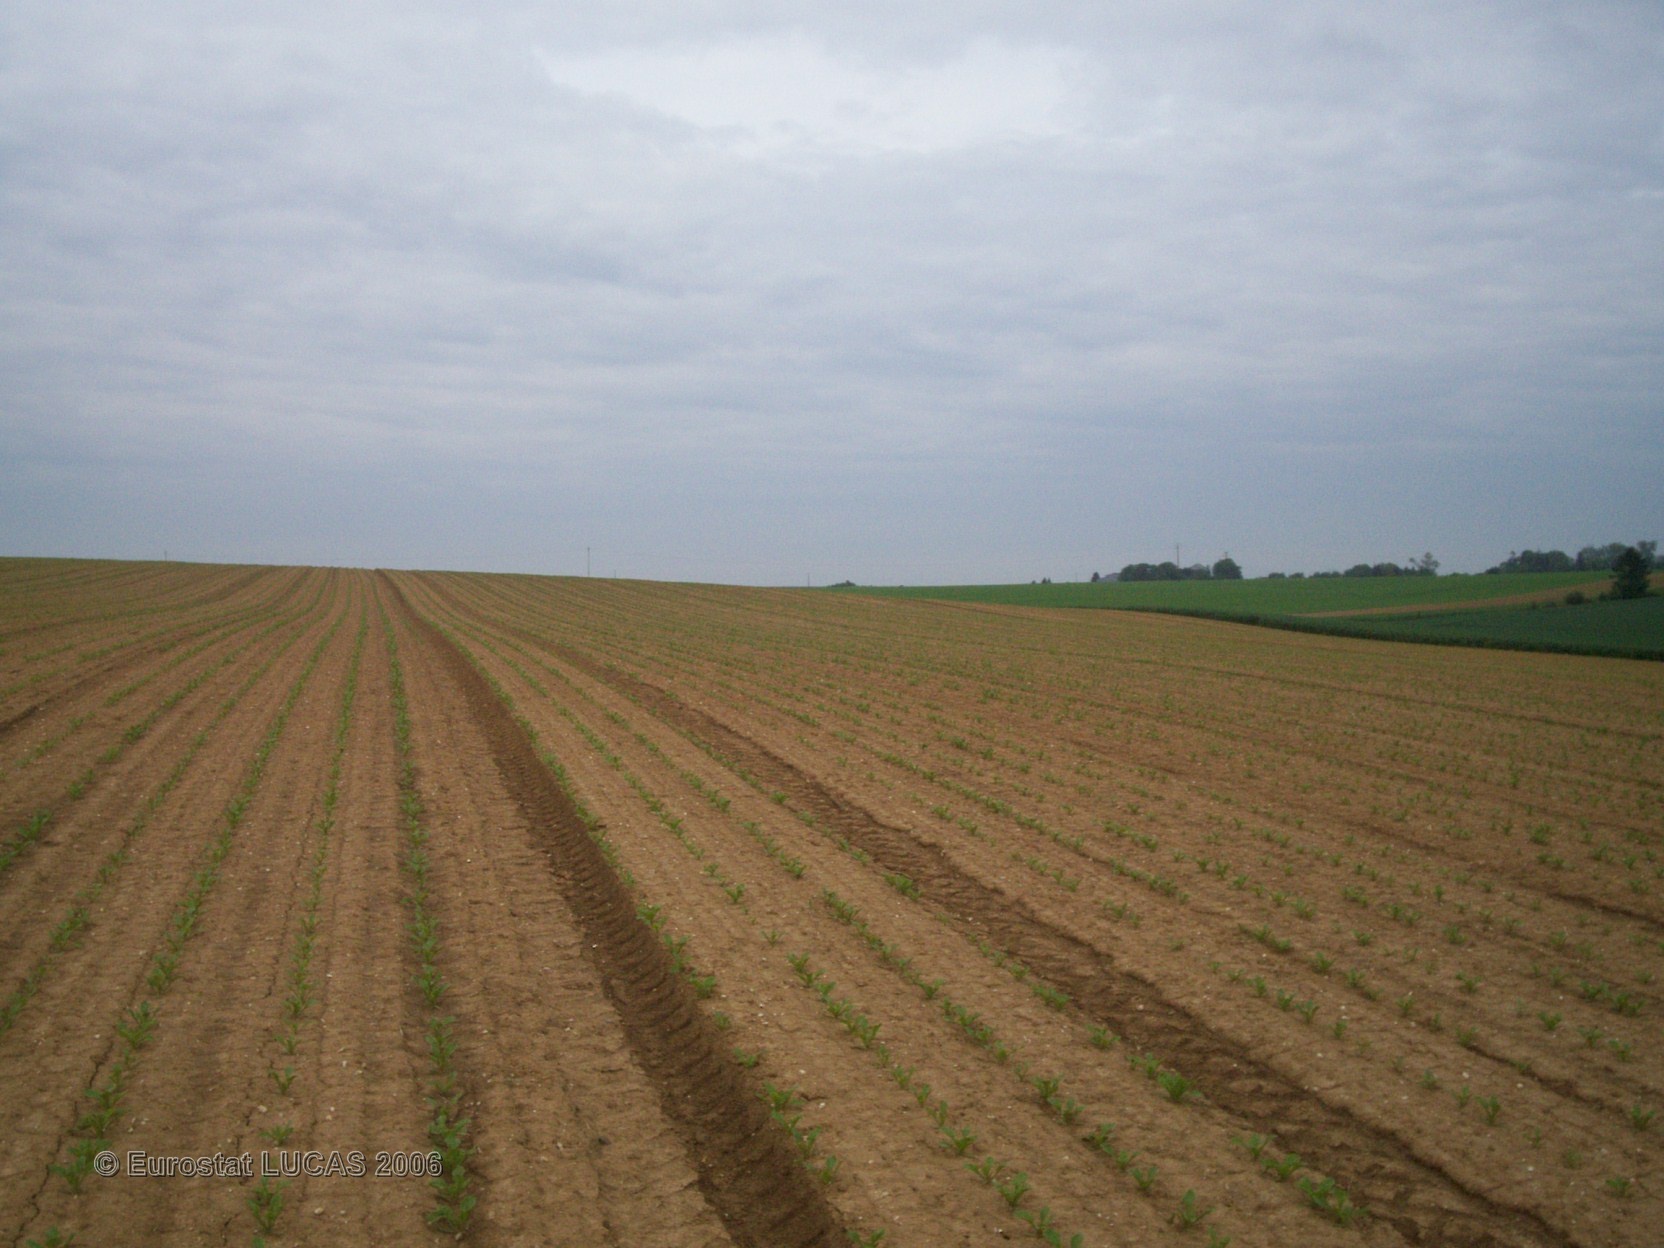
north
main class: Cropland
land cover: Sugar beet
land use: Agriculture (excluding fallow land and kitchen gardens)
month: May
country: FR
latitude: 49.8621
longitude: 3.6357
